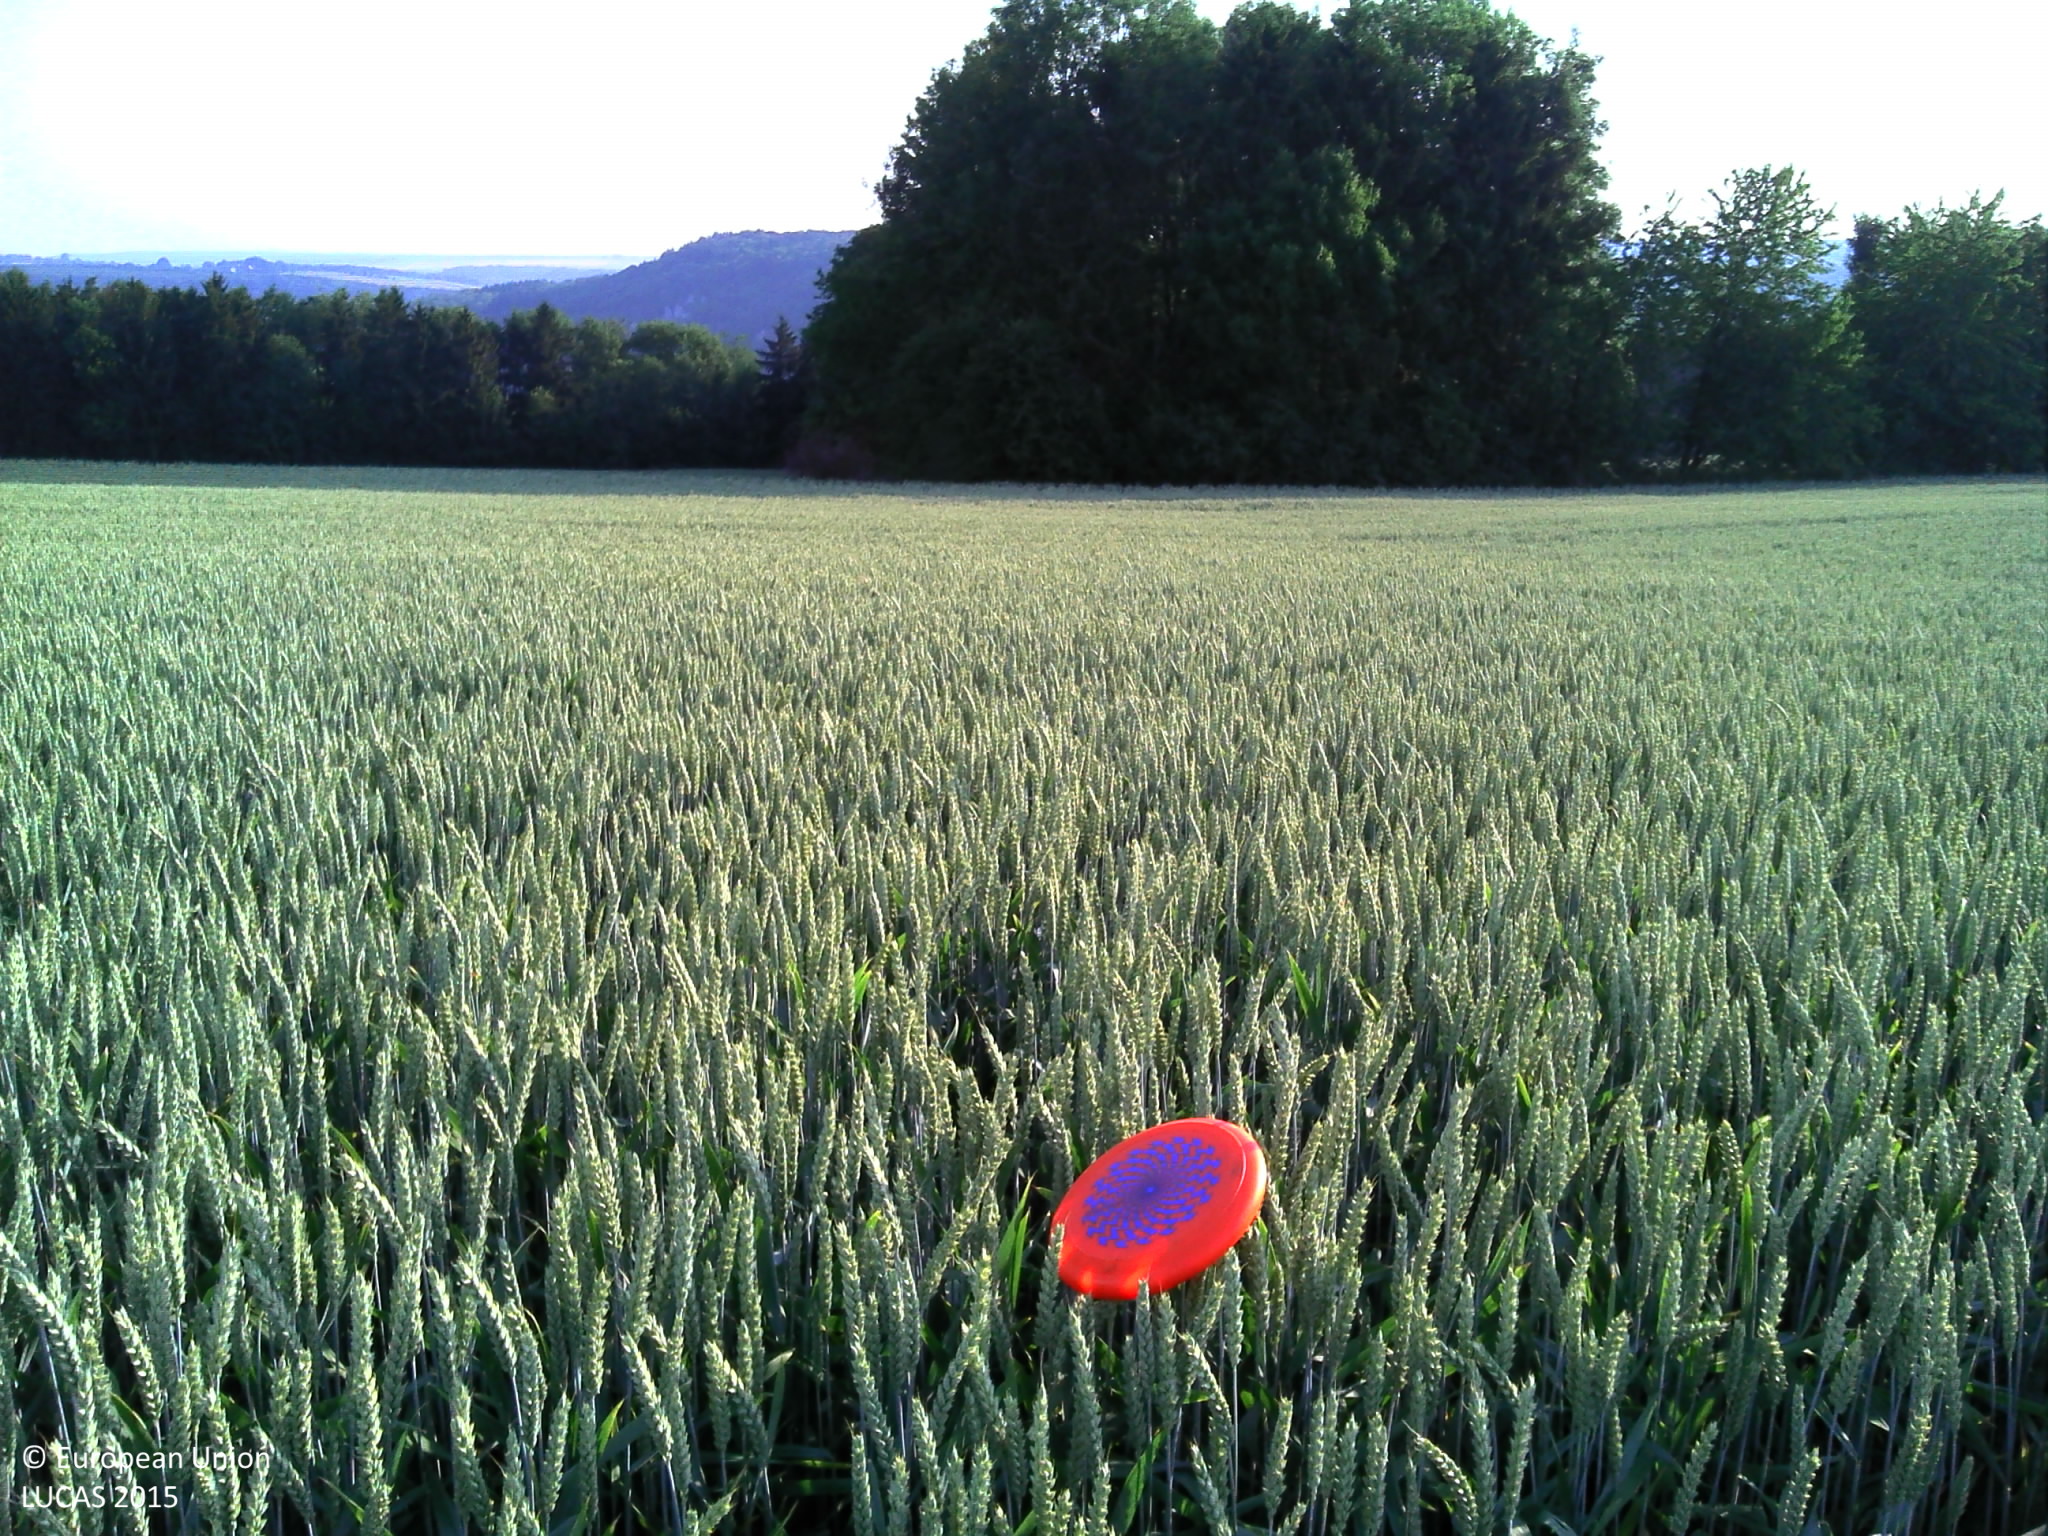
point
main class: Cropland
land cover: Common wheat
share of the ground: > 75 %
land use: Agriculture (excluding fallow land and kitchen gardens)
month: July
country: BE
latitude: 50.2148
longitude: 4.9100
